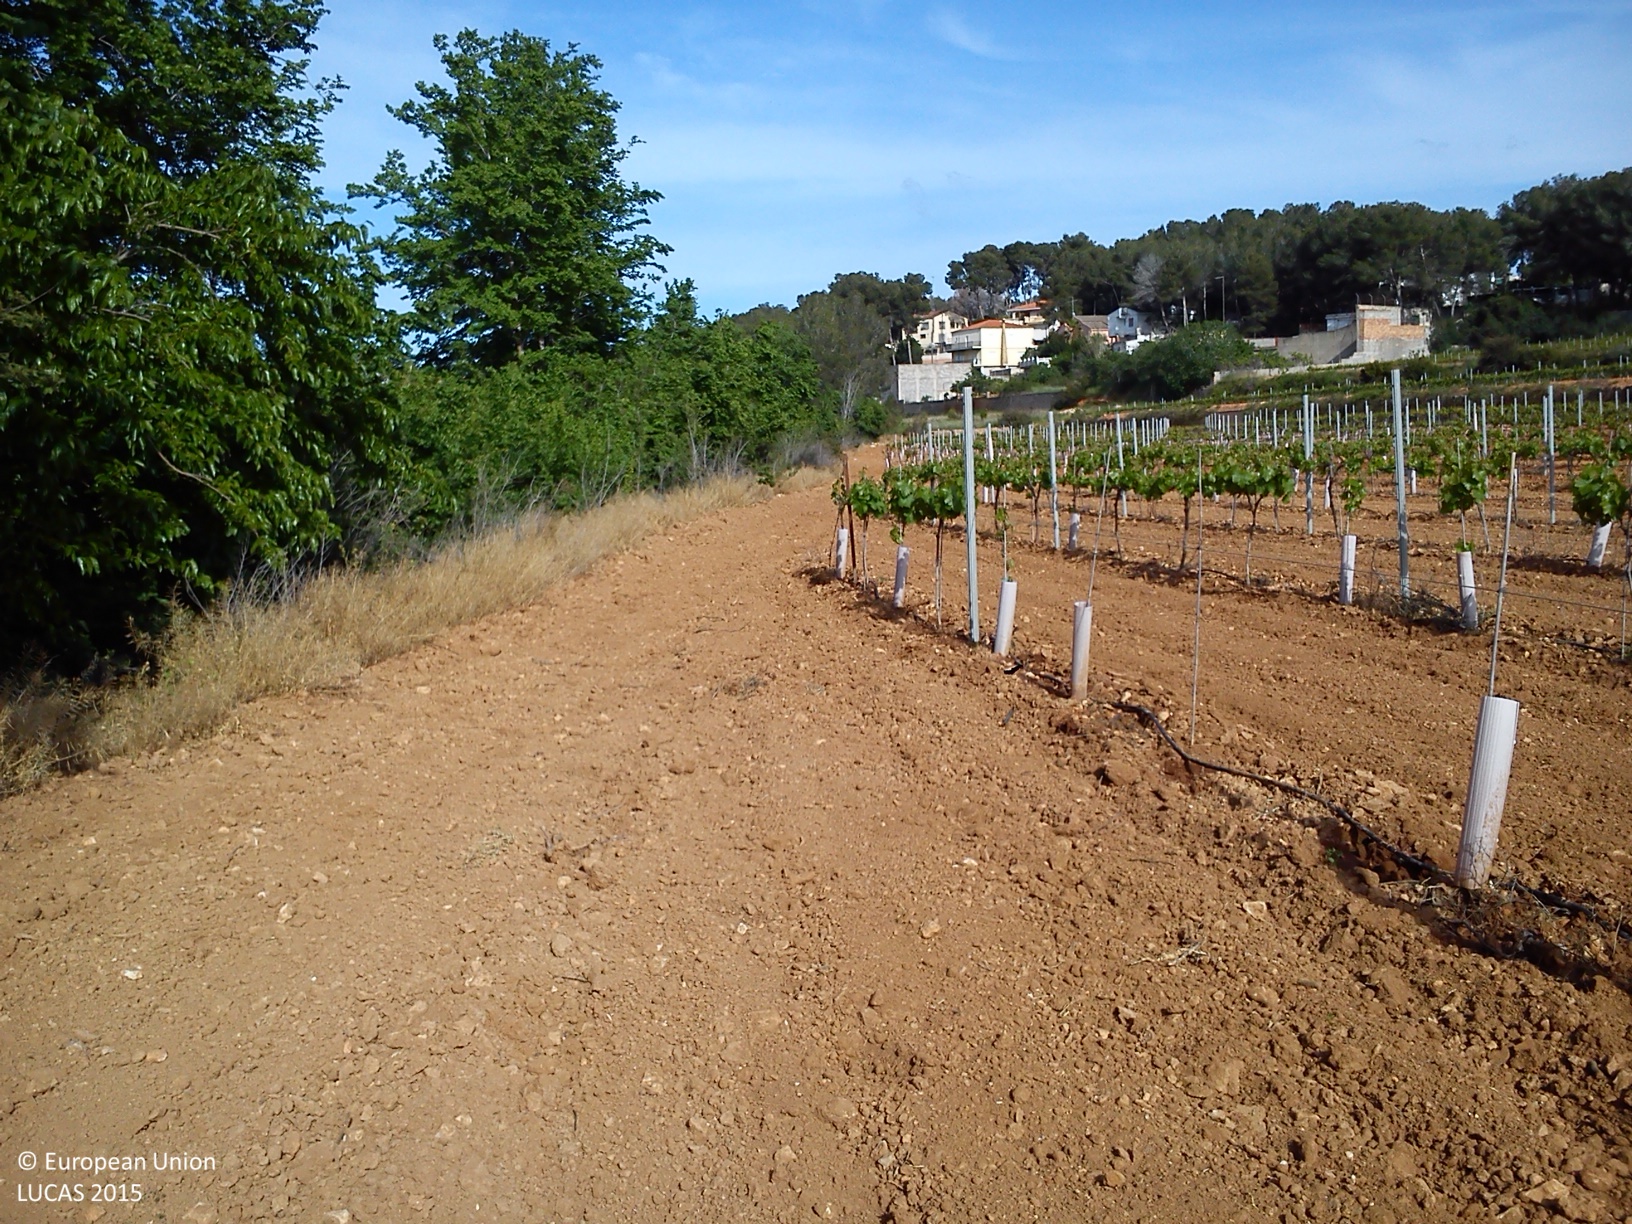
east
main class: Cropland
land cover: Vineyards
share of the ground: 10 - 25 %
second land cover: Other bare soil
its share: > 75 %
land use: Agriculture (excluding fallow land and kitchen gardens)
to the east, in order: Vineyards; Other bare soil; Grass margins; Broadleaved woodland; Artificial constructions in urban areas; Pine dominated coniferous woodland; Tracks
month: April
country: ES
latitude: 39.4330
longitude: -0.6283
